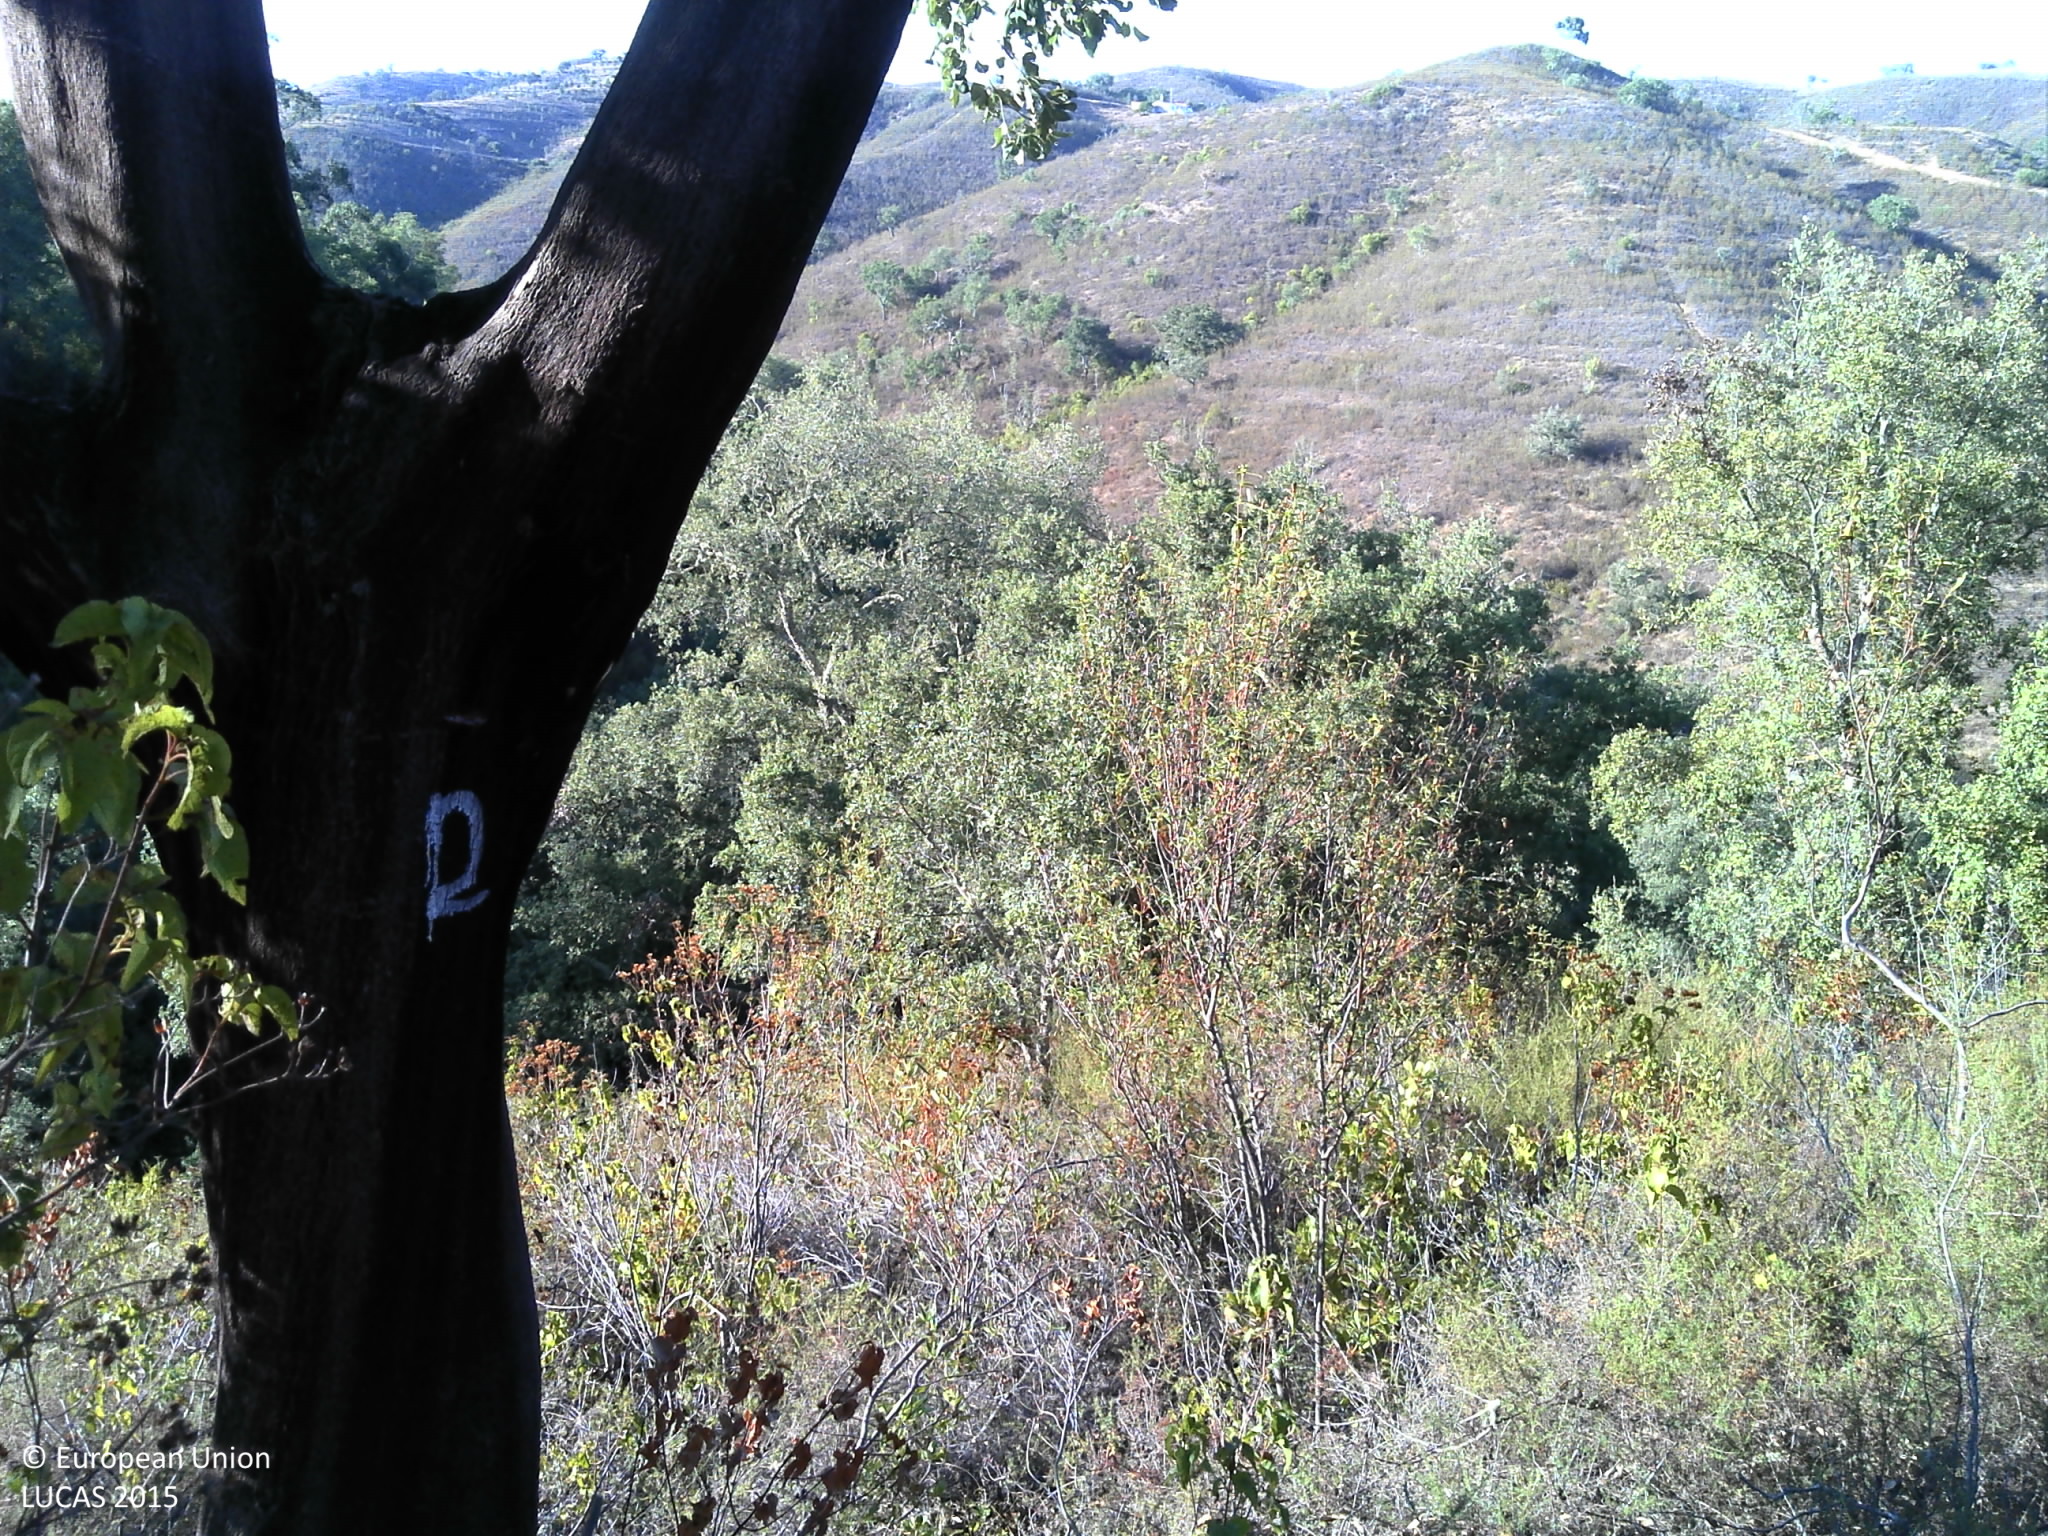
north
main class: Woodland
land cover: Broadleaved woodland
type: broadleaved evergreen forest
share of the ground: 25 - 50 %
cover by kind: broadleaved forest trees 40 %, shrubs 40 %, herbaceous plants 10 %, unconsolidated bare surface 10 %
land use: Forestry
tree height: > 5 m
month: September
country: PT
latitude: 37.4282
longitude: -8.2529
